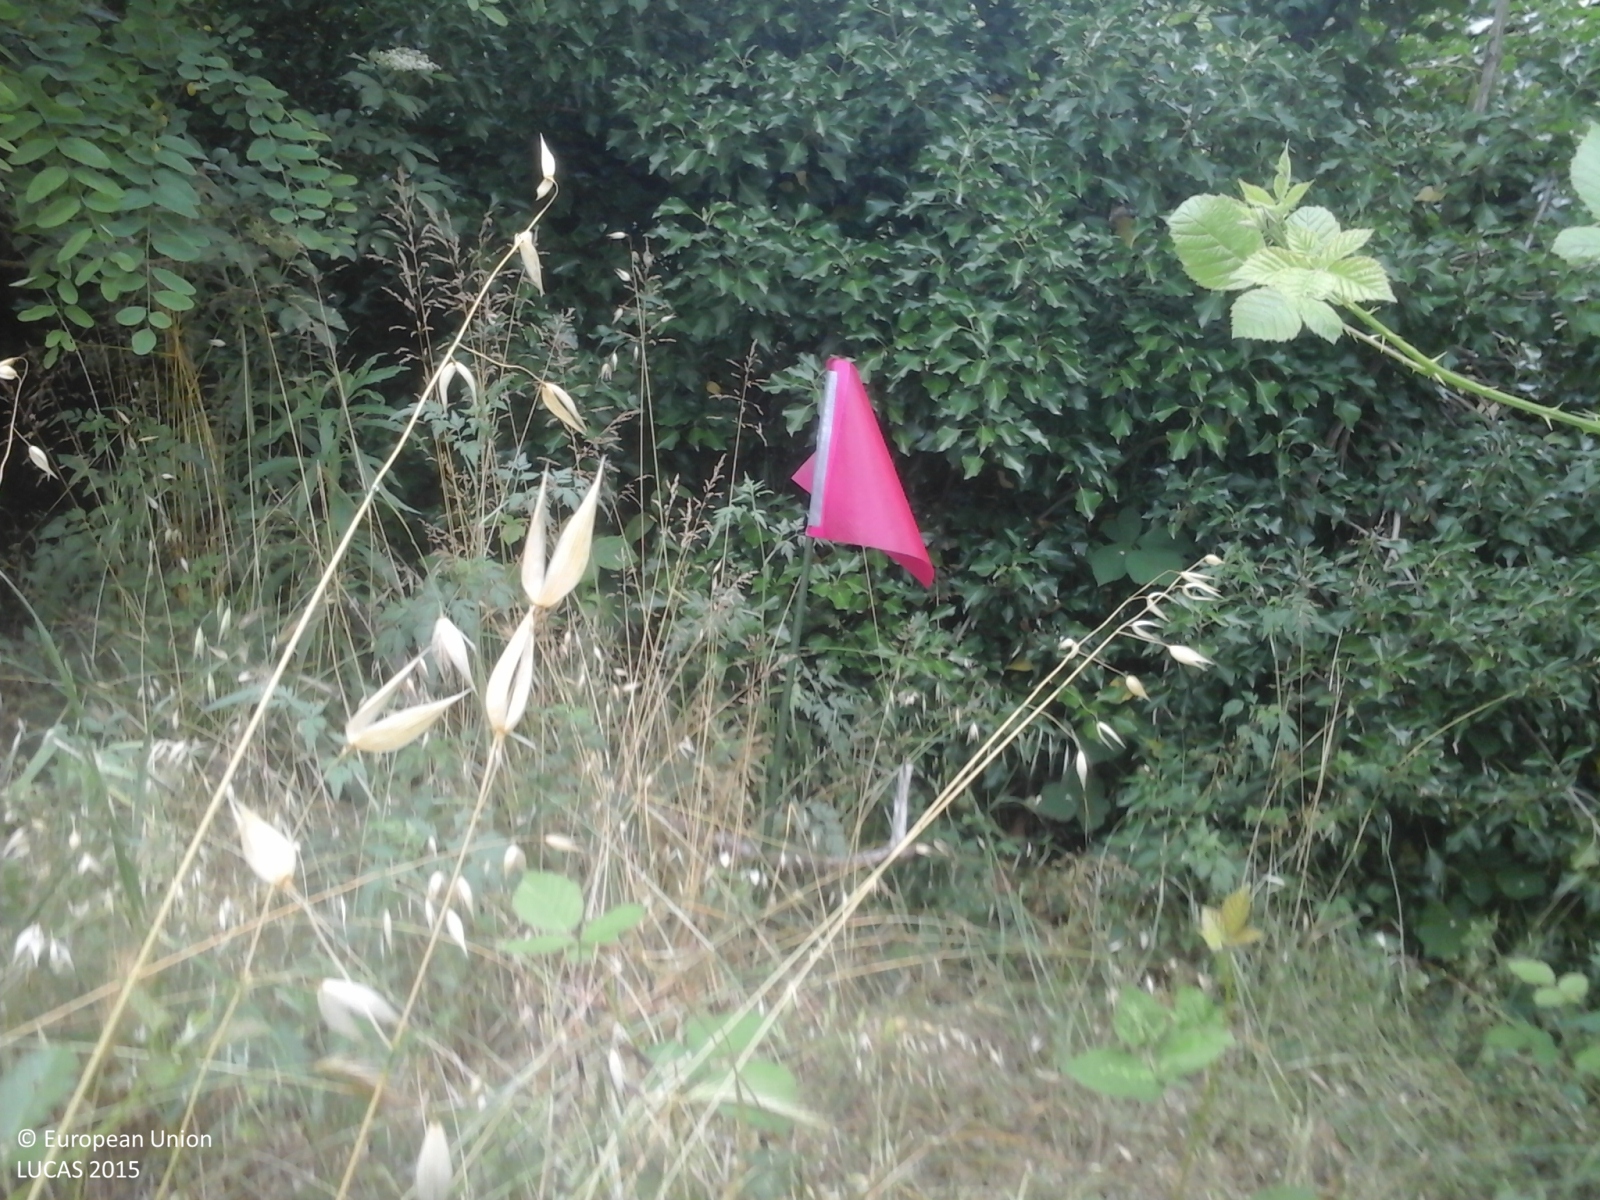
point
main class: Woodland
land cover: Broadleaved woodland
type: thermophilous deciduous forest
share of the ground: > 75 %
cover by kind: broadleaved forest trees 100 %
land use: Forestry
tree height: > 5 m
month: May
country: IT
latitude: 44.4162
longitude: 11.1654
